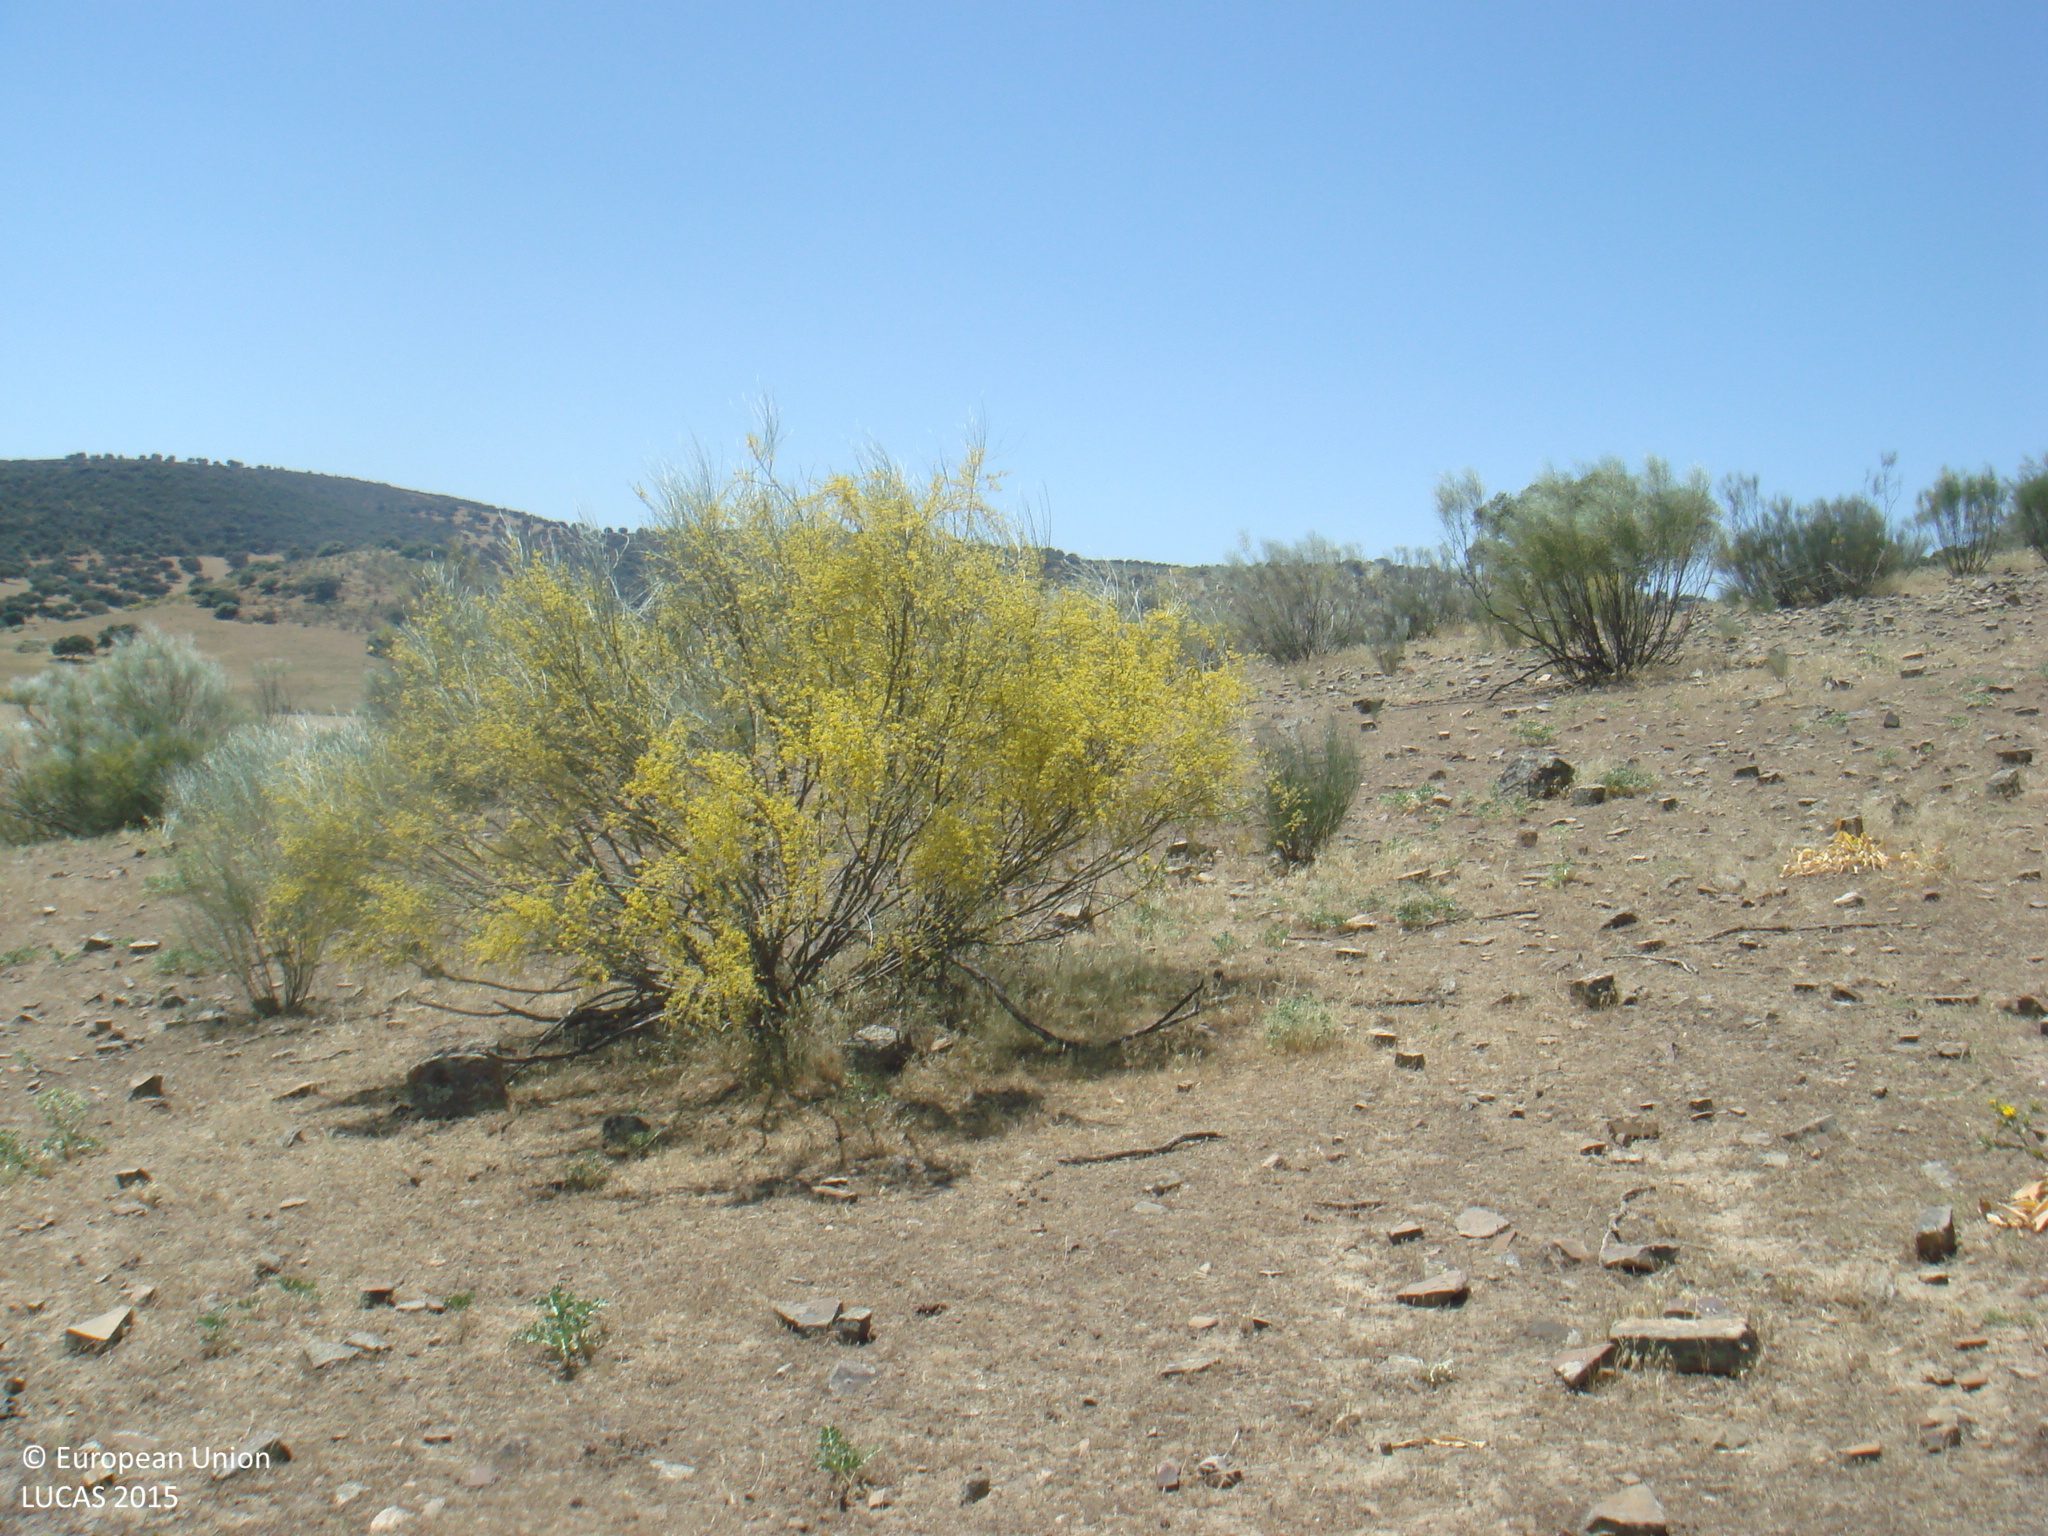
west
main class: Shrubland
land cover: Shrubland without tree cover
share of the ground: 10 - 25 %
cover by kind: herbaceous plants 75 %, shrubs 20 %
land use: Agriculture (excluding fallow land and kitchen gardens)
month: May
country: ES
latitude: 38.7039
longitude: -5.1076
